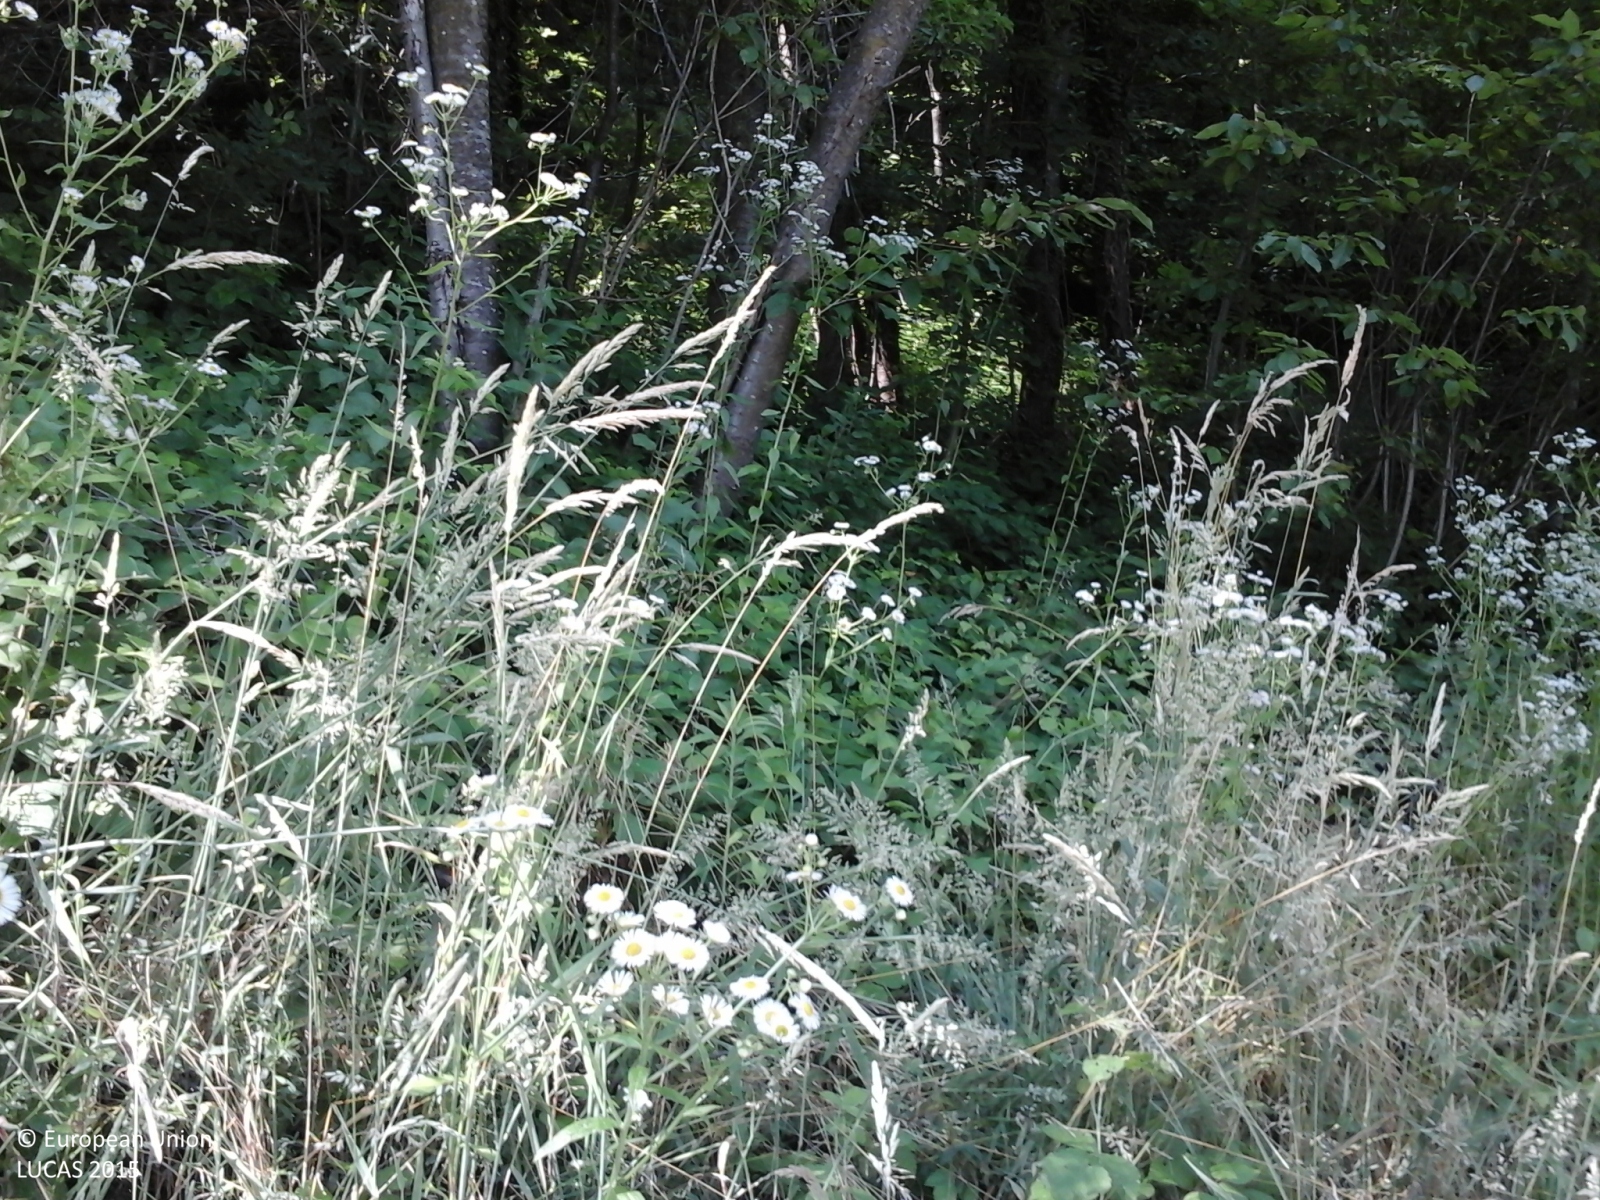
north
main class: Woodland
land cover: Broadleaved woodland
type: thermophilous deciduous forest
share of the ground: > 75 %
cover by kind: broadleaved forest trees 40 %, shrubs 40 %, herbaceous plants 20 %
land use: Forestry
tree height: > 5 m
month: June
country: IT
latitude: 44.3100
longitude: 7.8360
